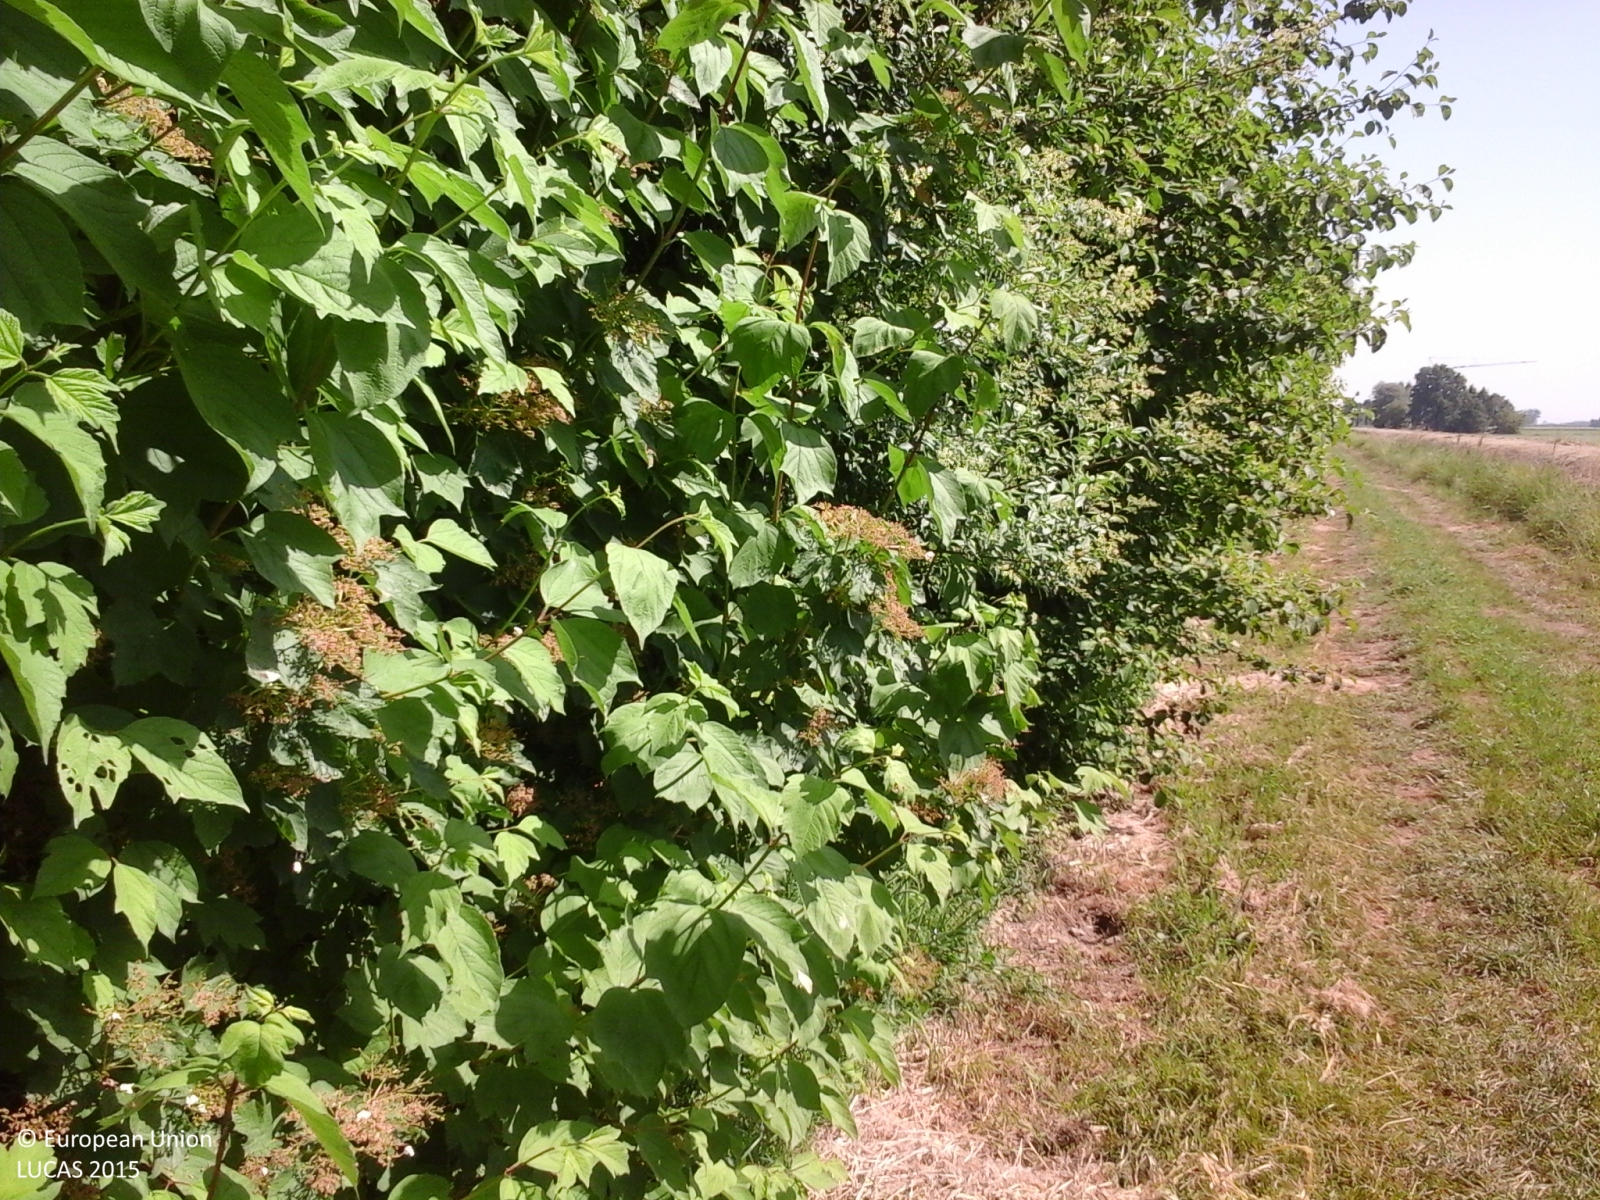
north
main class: Woodland
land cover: Broadleaved woodland
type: thermophilous deciduous forest
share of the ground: > 75 %
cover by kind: broadleaved forest trees 85 %, herbaceous plants 10 %, shrubs 5 %
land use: Other primary production
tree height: < 5 m
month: May
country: IT
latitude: 44.7407
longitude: 11.1721
